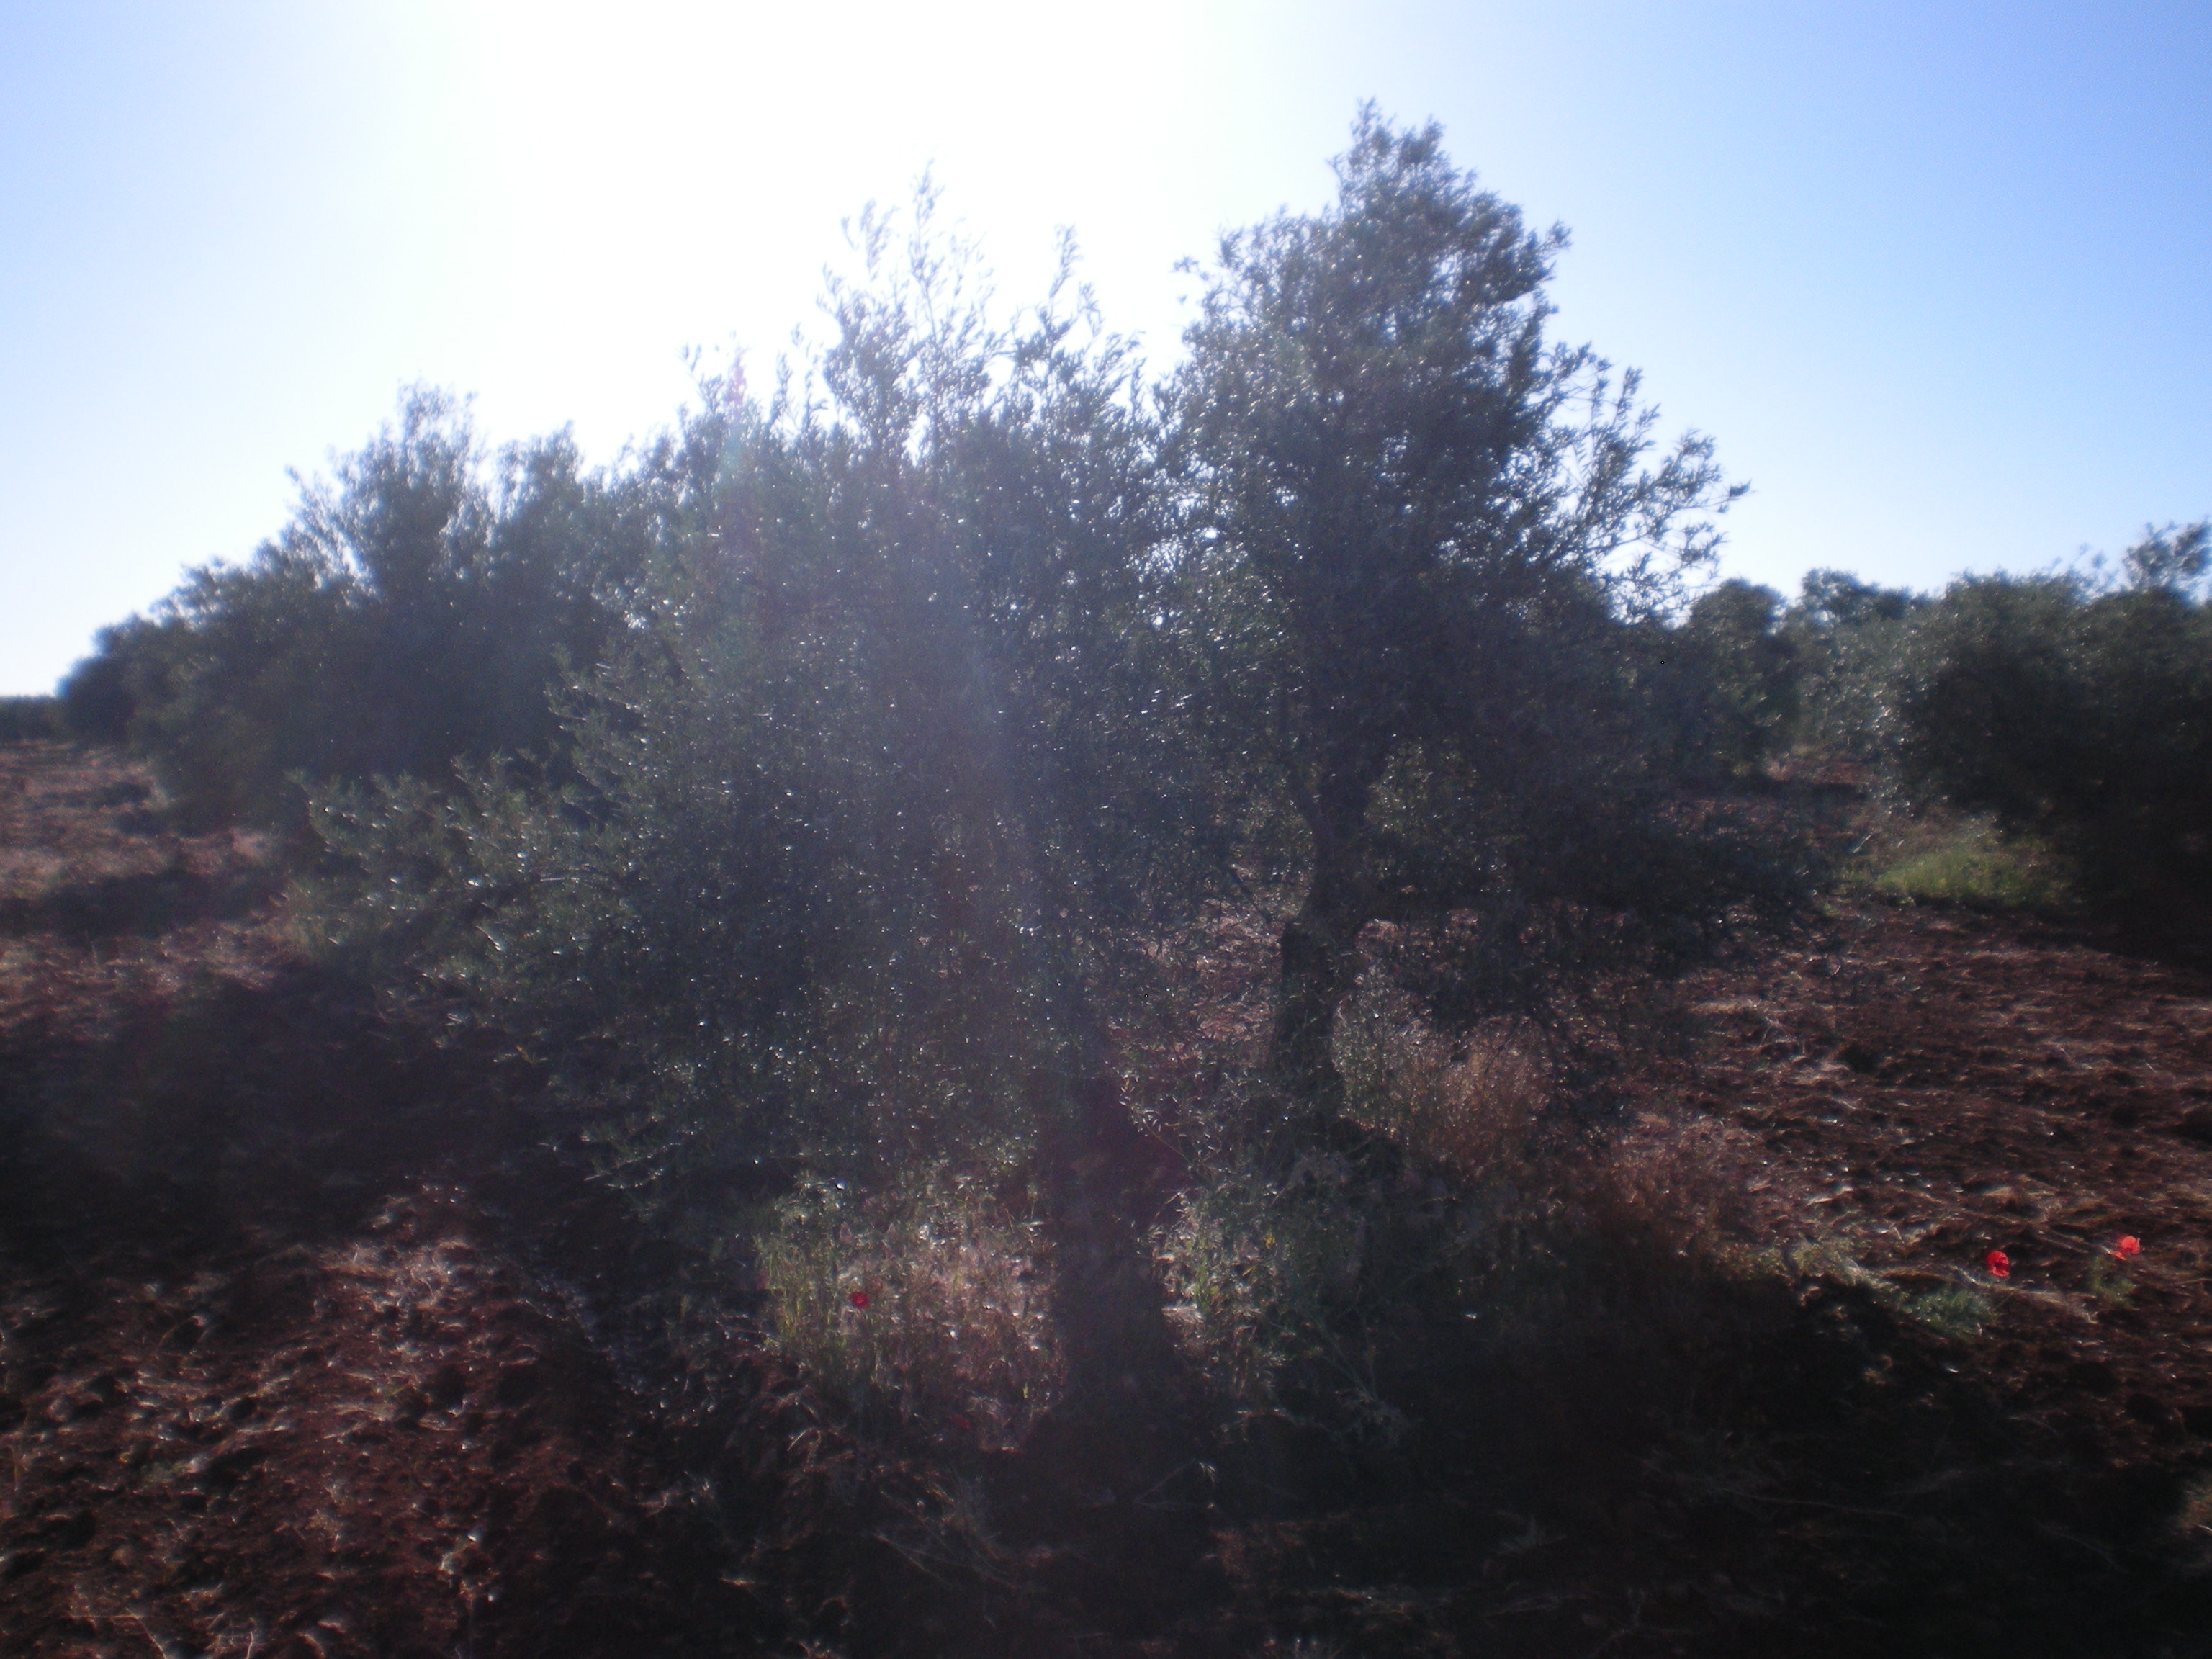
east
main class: Cropland
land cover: Olive groves
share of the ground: 10 - 25 %
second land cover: Other bare soil
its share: > 75 %
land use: Agriculture (excluding fallow land and kitchen gardens)
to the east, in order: Olive groves; Other bare soil
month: May
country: ES
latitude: 38.6746
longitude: -2.9362
